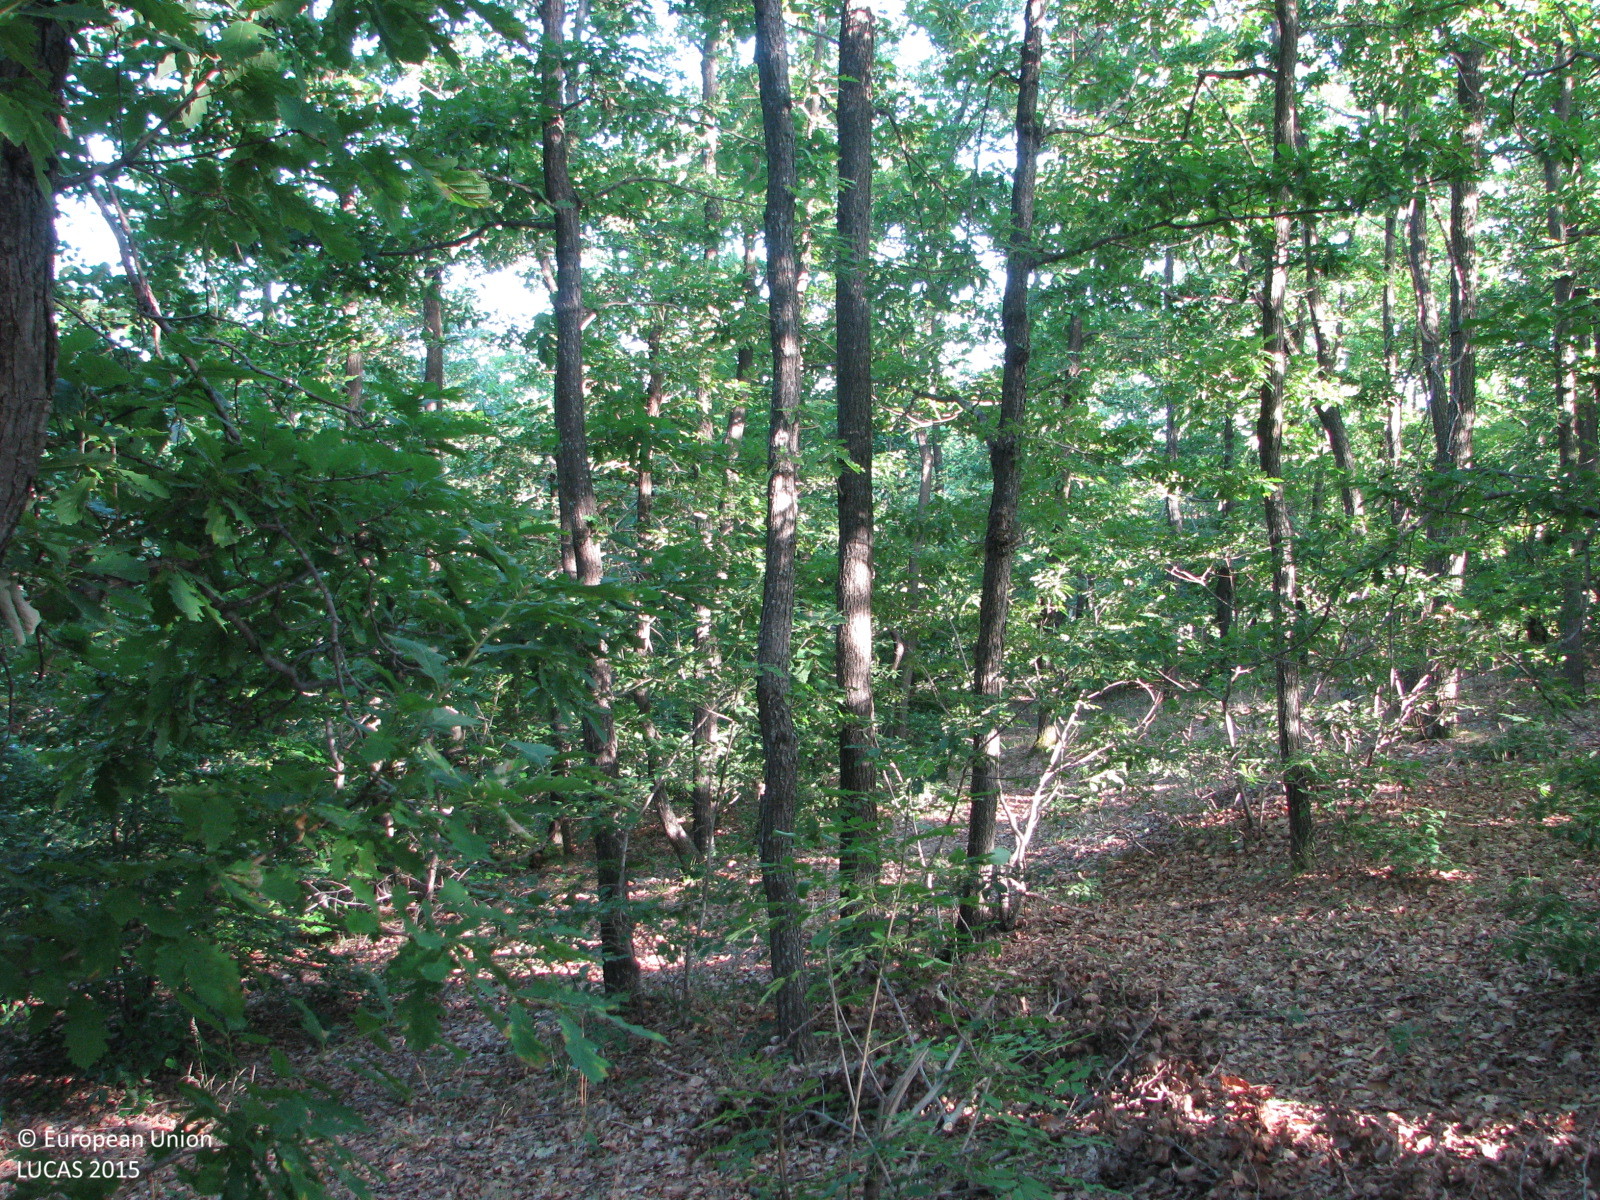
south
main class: Woodland
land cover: Broadleaved woodland
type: beech forest
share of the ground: 50 - 75 %
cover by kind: broadleaved forest trees 70 %, unconsolidated bare surface 20 %, shrubs 5 %, herbaceous plants 5 %
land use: Forestry
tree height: > 5 m
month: August
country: BG
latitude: 42.7212
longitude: 26.2952
